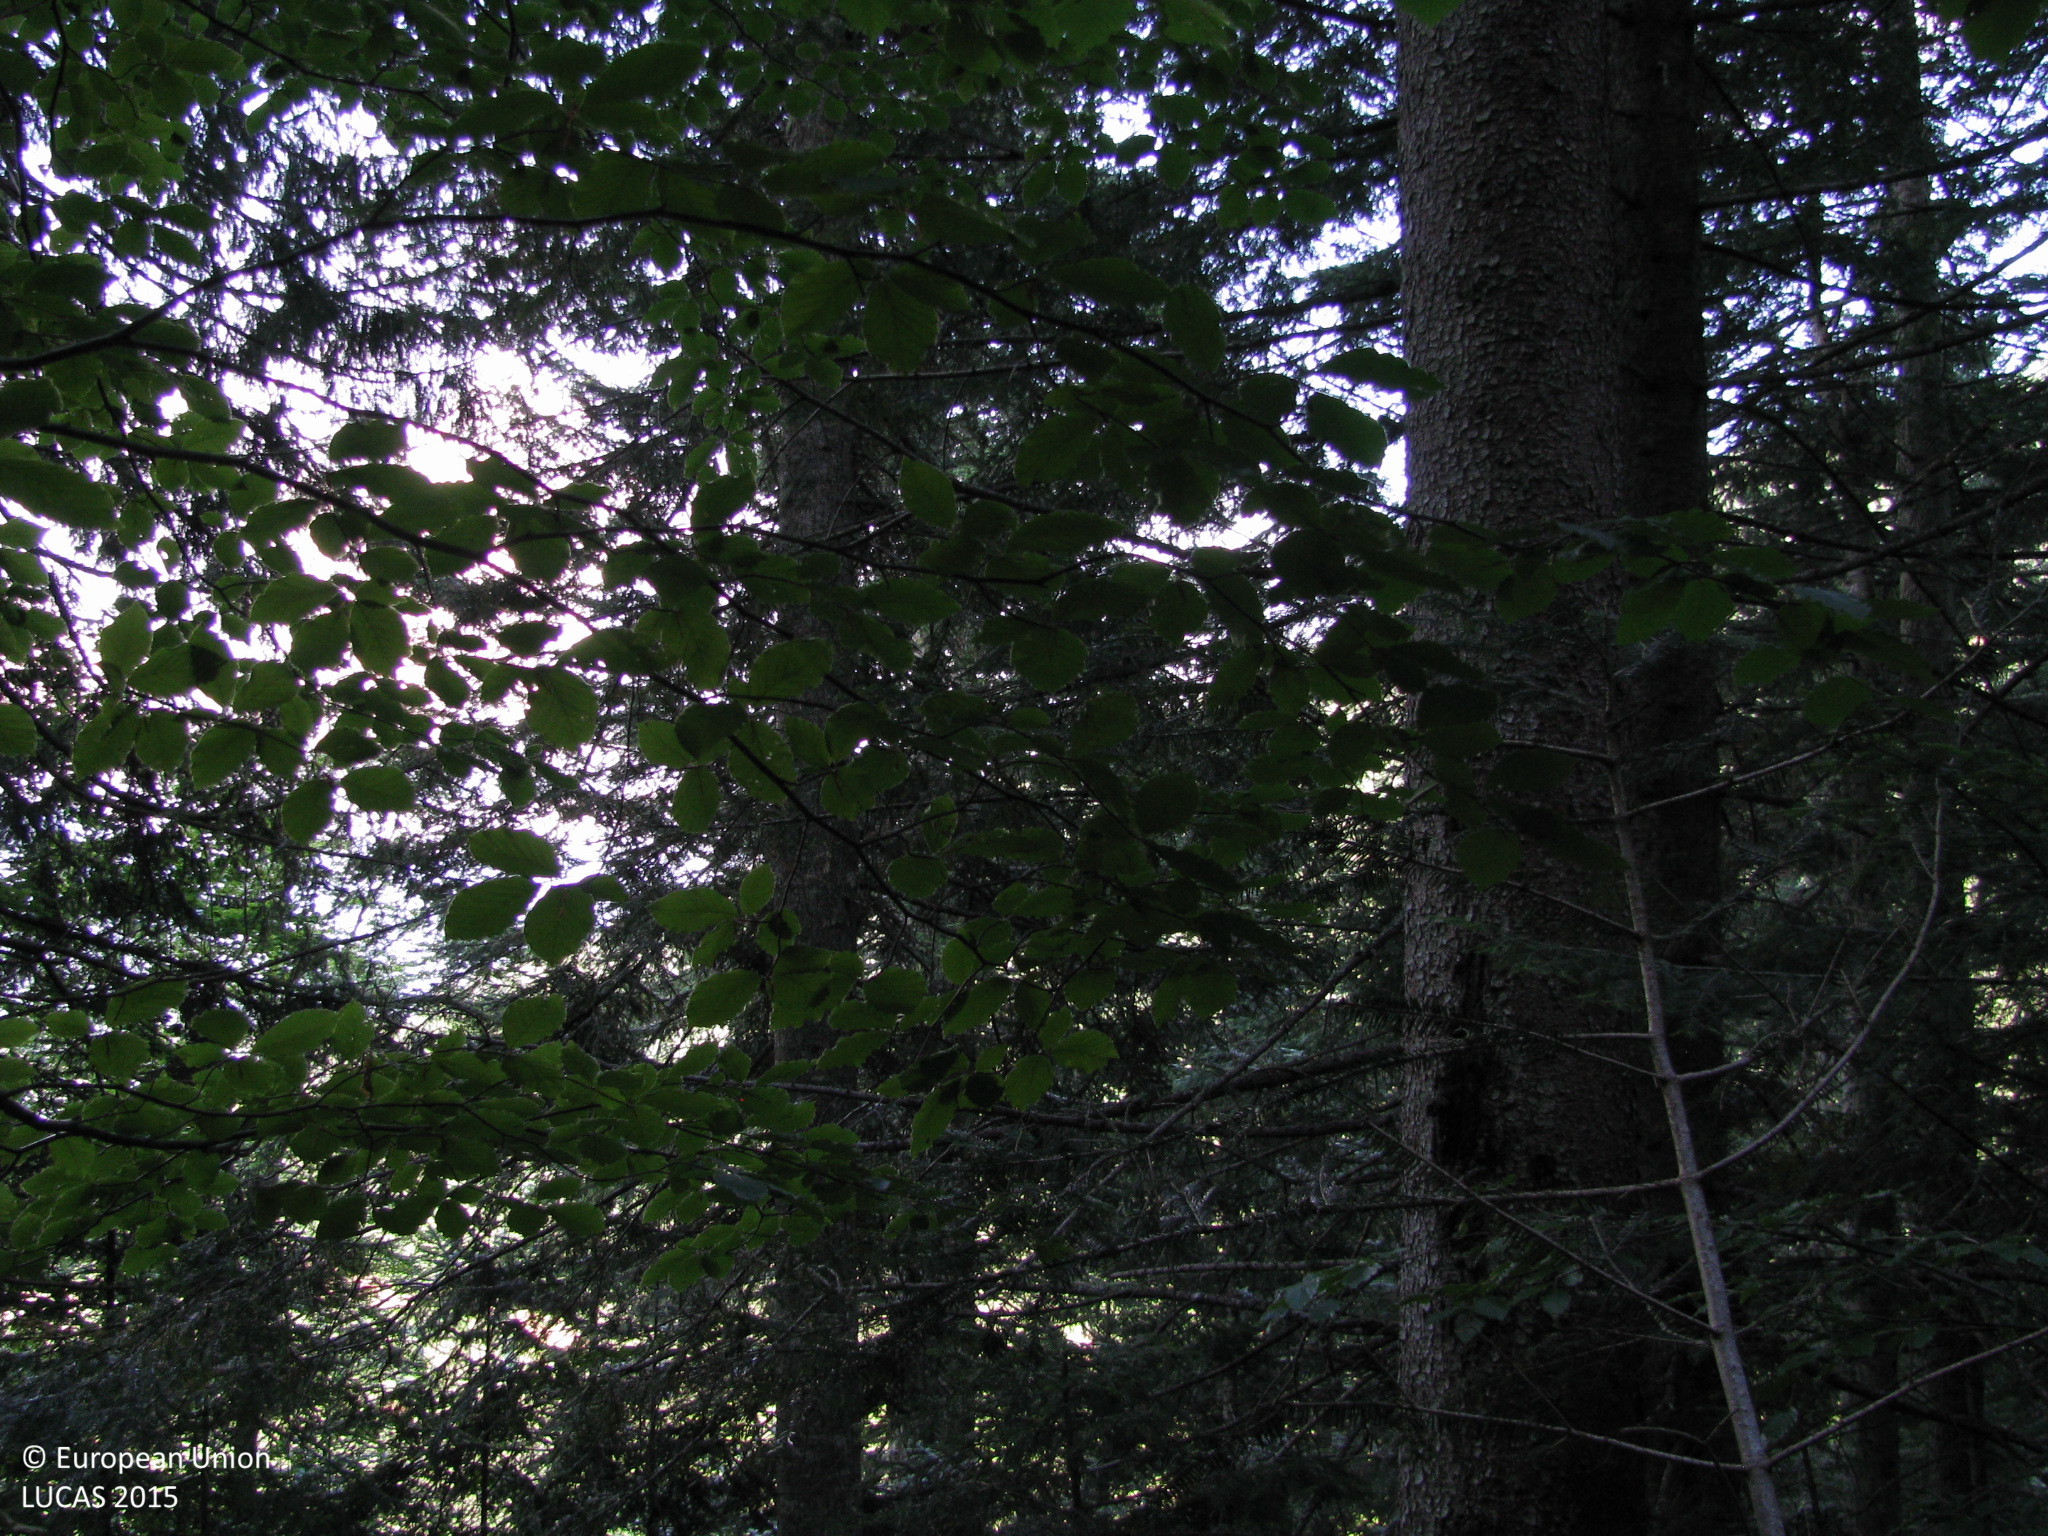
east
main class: Woodland
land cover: Other coniferous woodland
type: alpine coniferous forest
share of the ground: > 75 %
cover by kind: coniferous forest trees 75 %, broadleaved forest trees 15 %, herbaceous plants 10 %
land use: Forestry
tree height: > 5 m
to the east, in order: Other coniferous woodland; Other mixed woodland; Tracks; Other mixed woodland; Broadleaved woodland
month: July
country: AT
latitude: 46.6741
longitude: 12.8340
